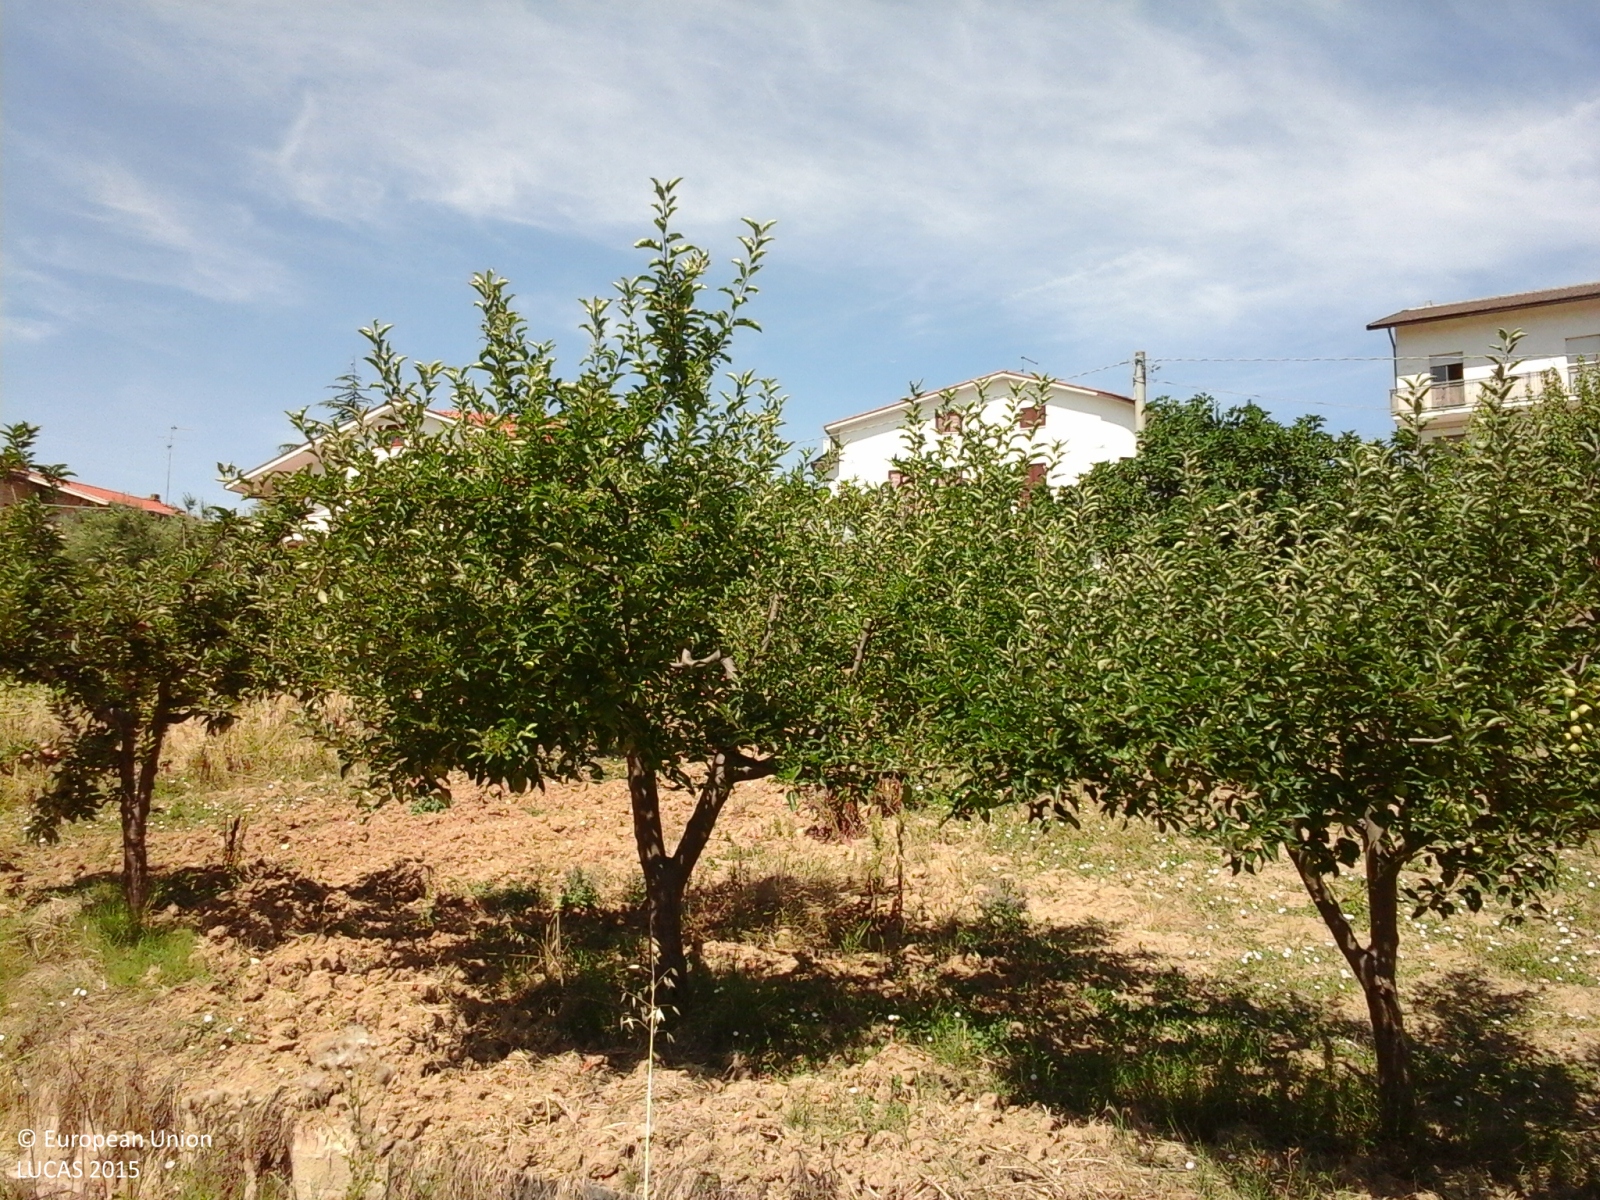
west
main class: Cropland
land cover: Olive groves
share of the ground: 25 - 50 %
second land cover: Spontaneously vegetated surfaces
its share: > 75 %
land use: Agriculture (excluding fallow land and kitchen gardens)
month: June
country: IT
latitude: 42.2685
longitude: 14.4119
